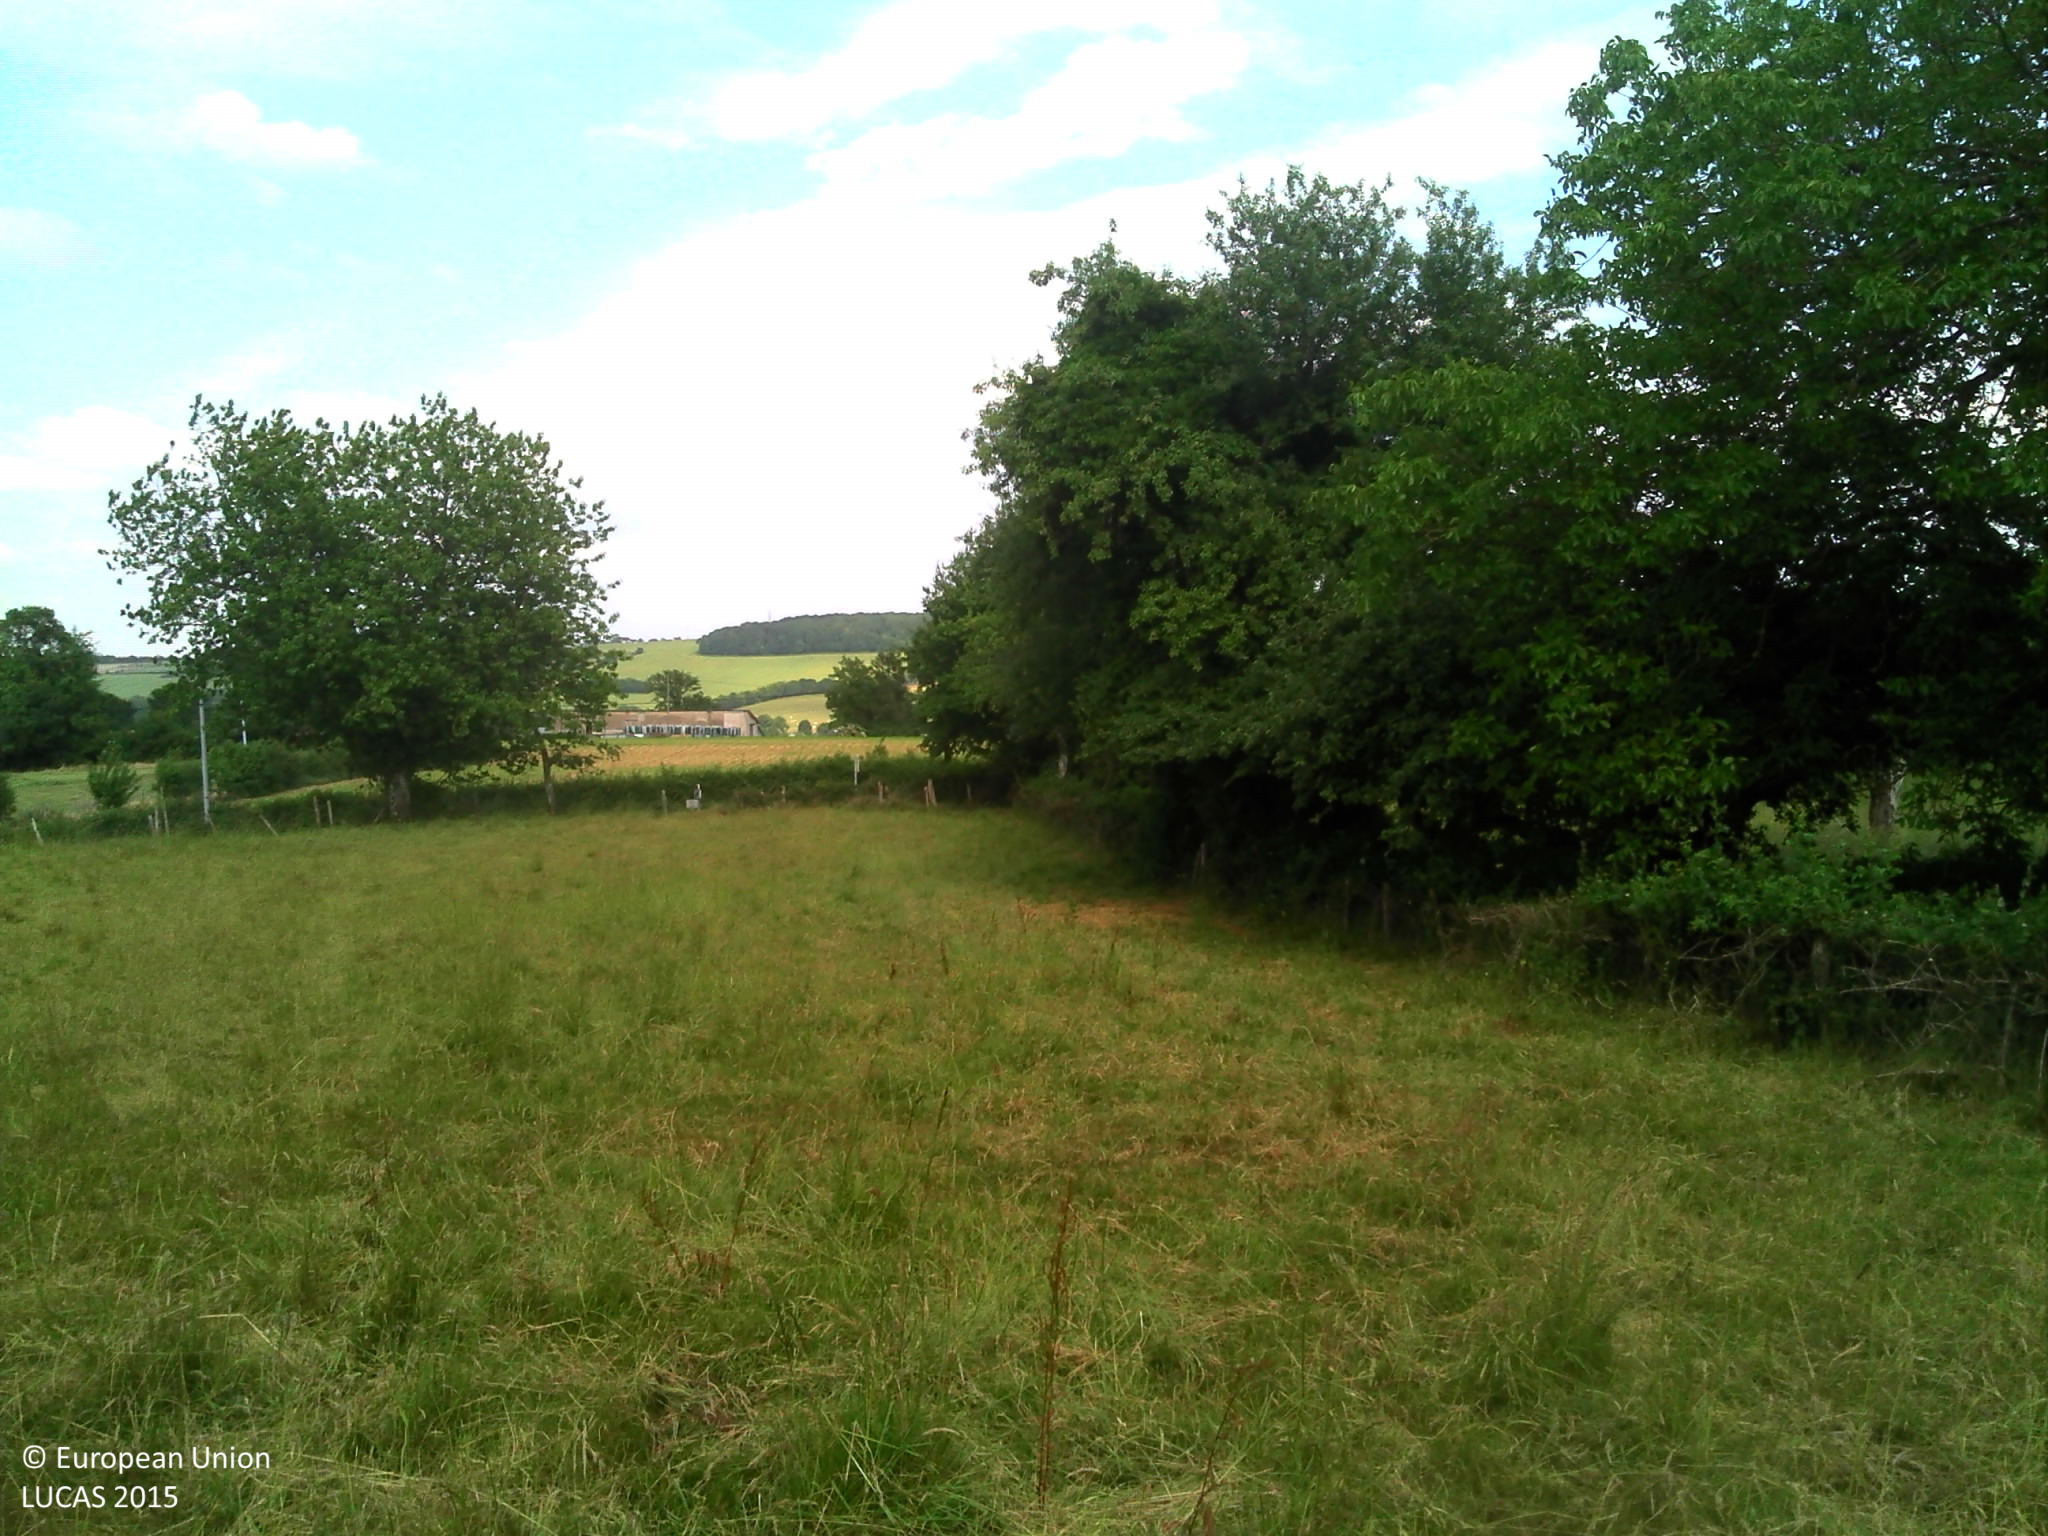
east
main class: Grassland
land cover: Grassland without tree/shrub cover
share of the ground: > 75 %
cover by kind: herbaceous plants 100 %
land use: Agriculture (excluding fallow land and kitchen gardens)
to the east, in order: Grassland without tree/shrub cover; Fences; Ditches and canals; Grass margins; Paved roads, cycling and walking lanes; Grass margins; Ditches and canals; Abandoned hedges; Fences; Maize
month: June
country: FR
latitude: 47.2202
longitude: 3.2216
